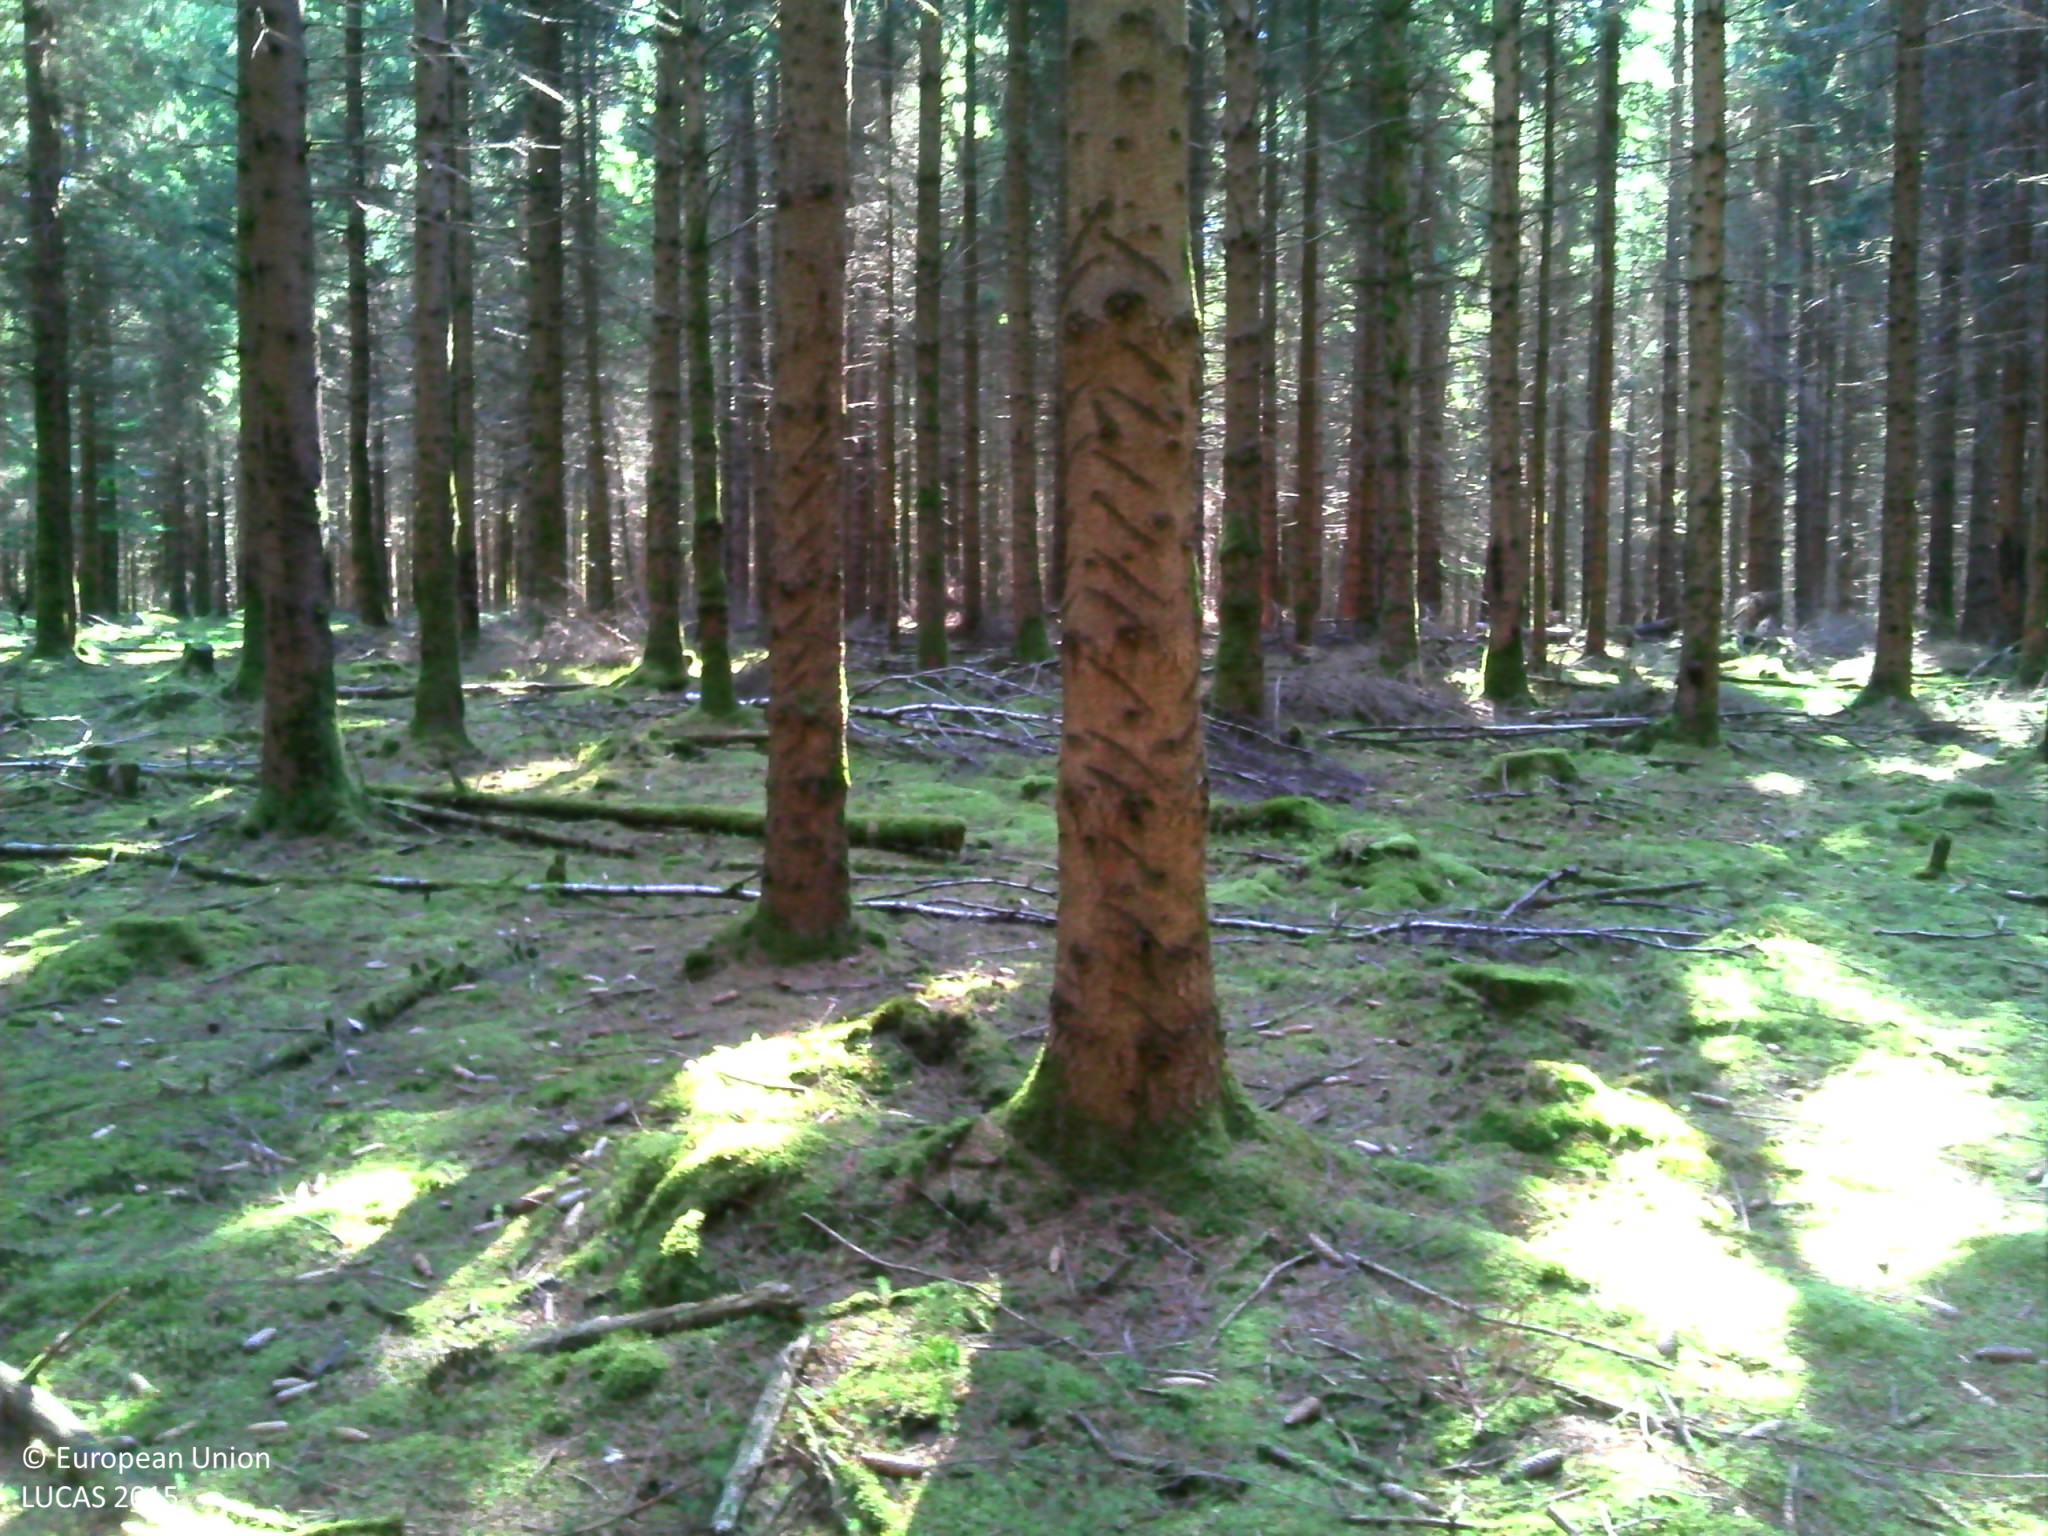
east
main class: Woodland
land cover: Spruce dominated coniferous woodland
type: alpine coniferous forest
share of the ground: > 75 %
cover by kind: coniferous forest trees 95 %, lichens and mosses 5 %
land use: Forestry
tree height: > 5 m
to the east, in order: Spruce dominated coniferous woodland; Tracks; Spruce dominated coniferous woodland; Rock outcrops; Spruce dominated coniferous woodland
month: July
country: BE
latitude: 50.1773
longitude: 5.7558
